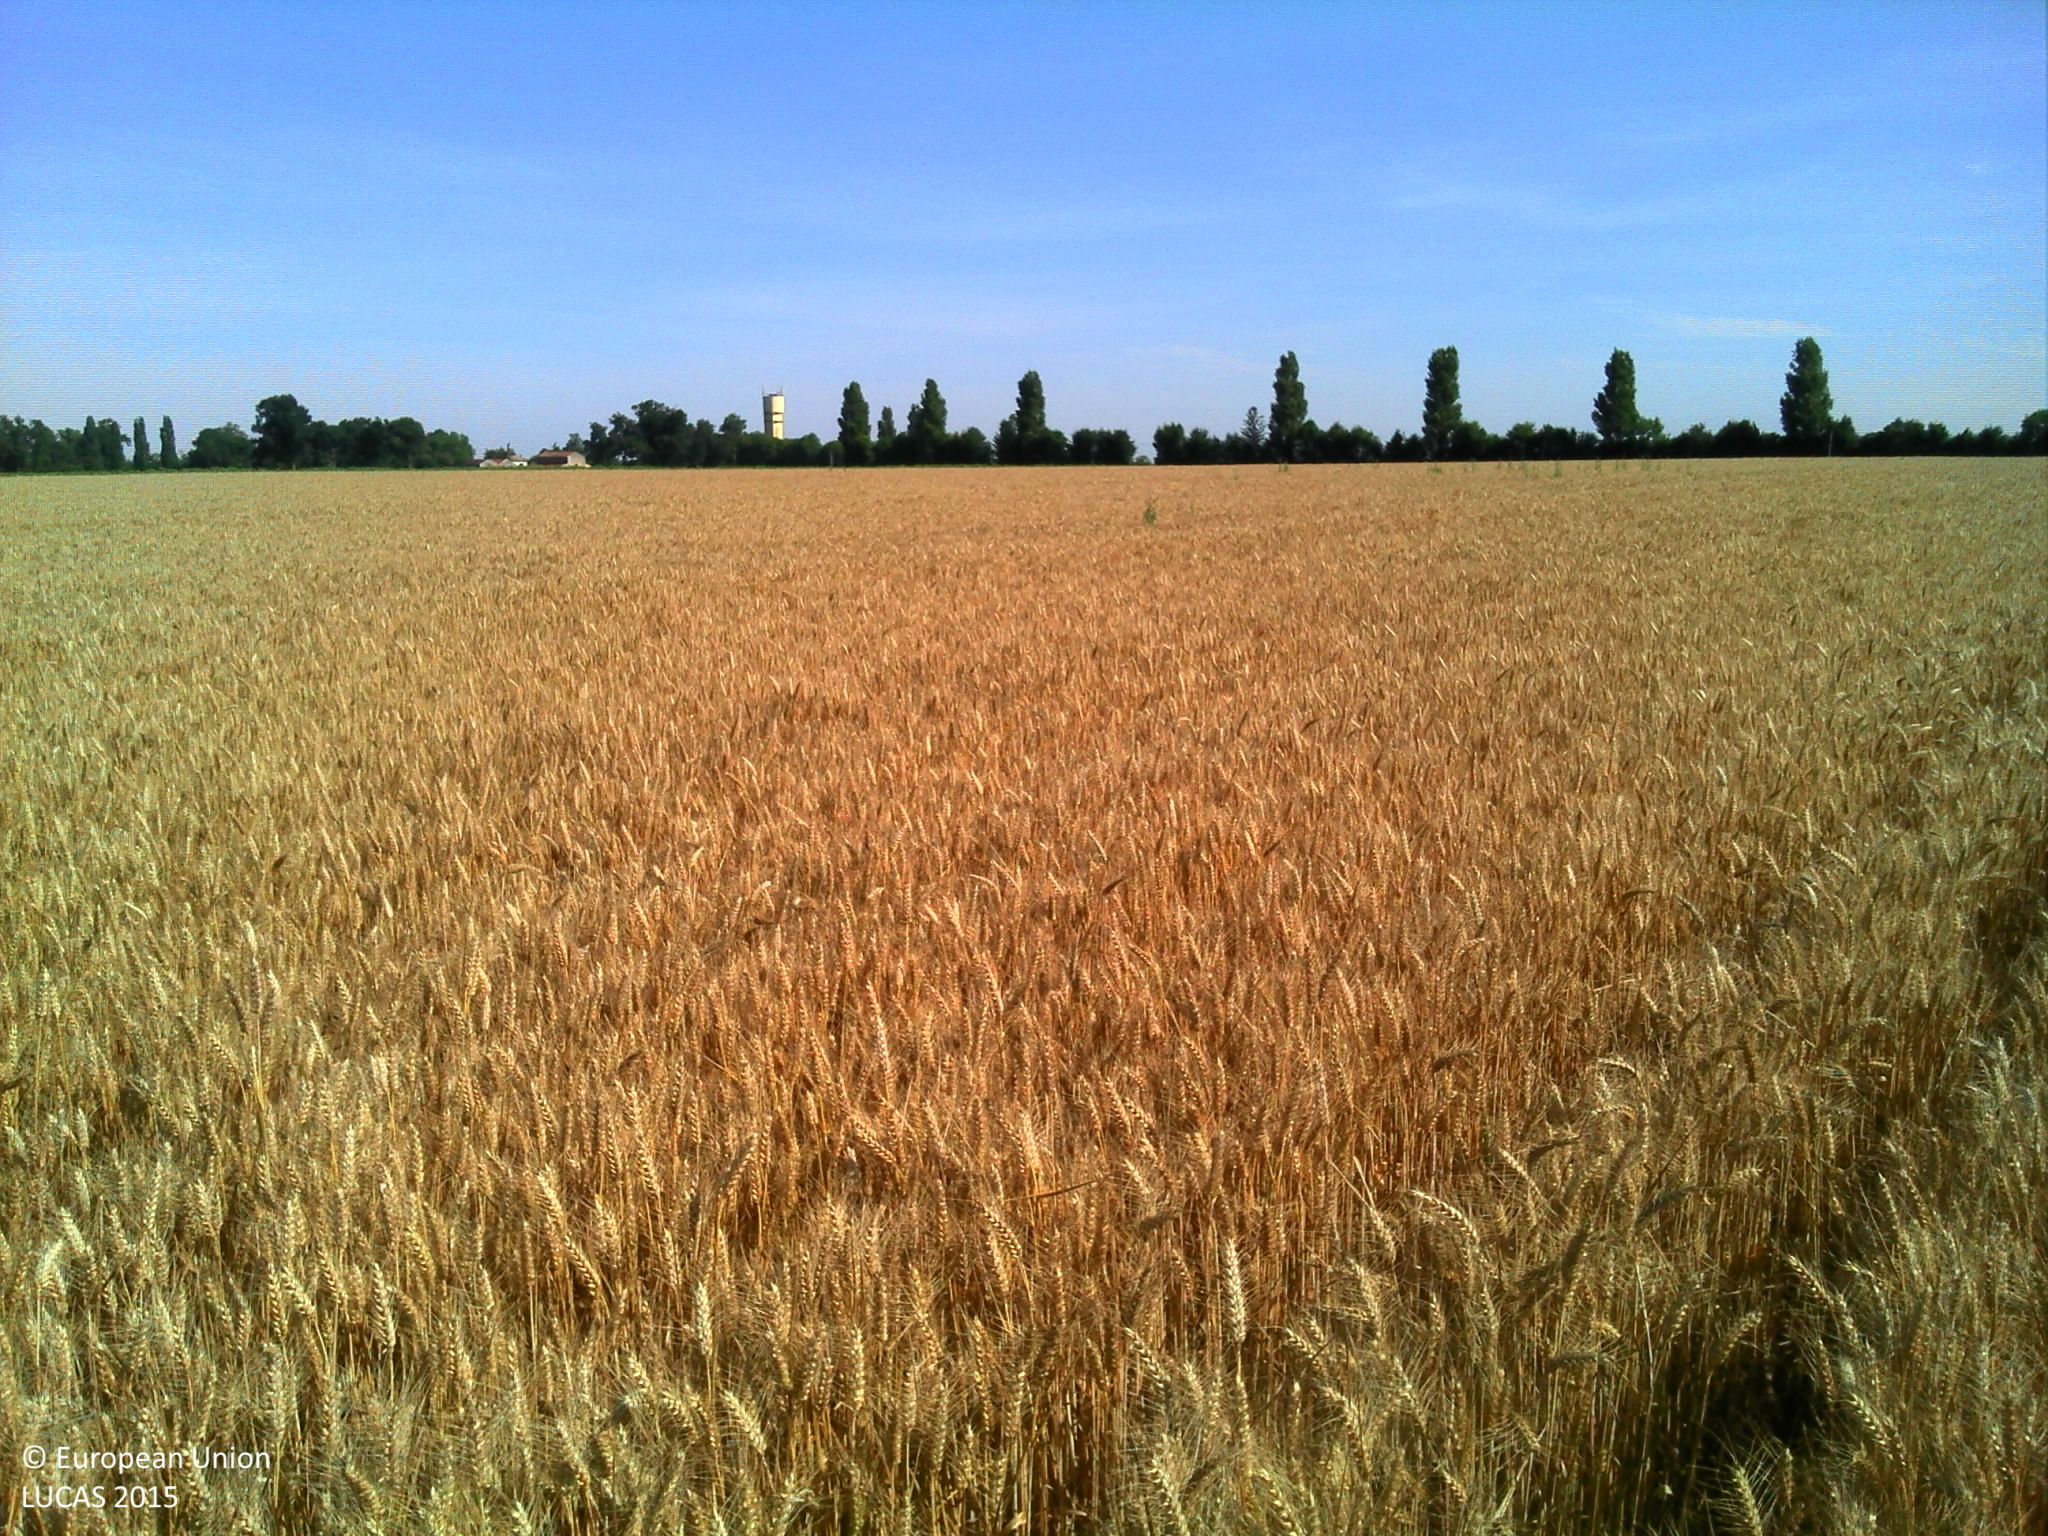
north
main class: Cropland
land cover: Durum wheat
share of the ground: > 75 %
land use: Agriculture (excluding fallow land and kitchen gardens)
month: June
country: FR
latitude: 45.8109
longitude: -0.7192
